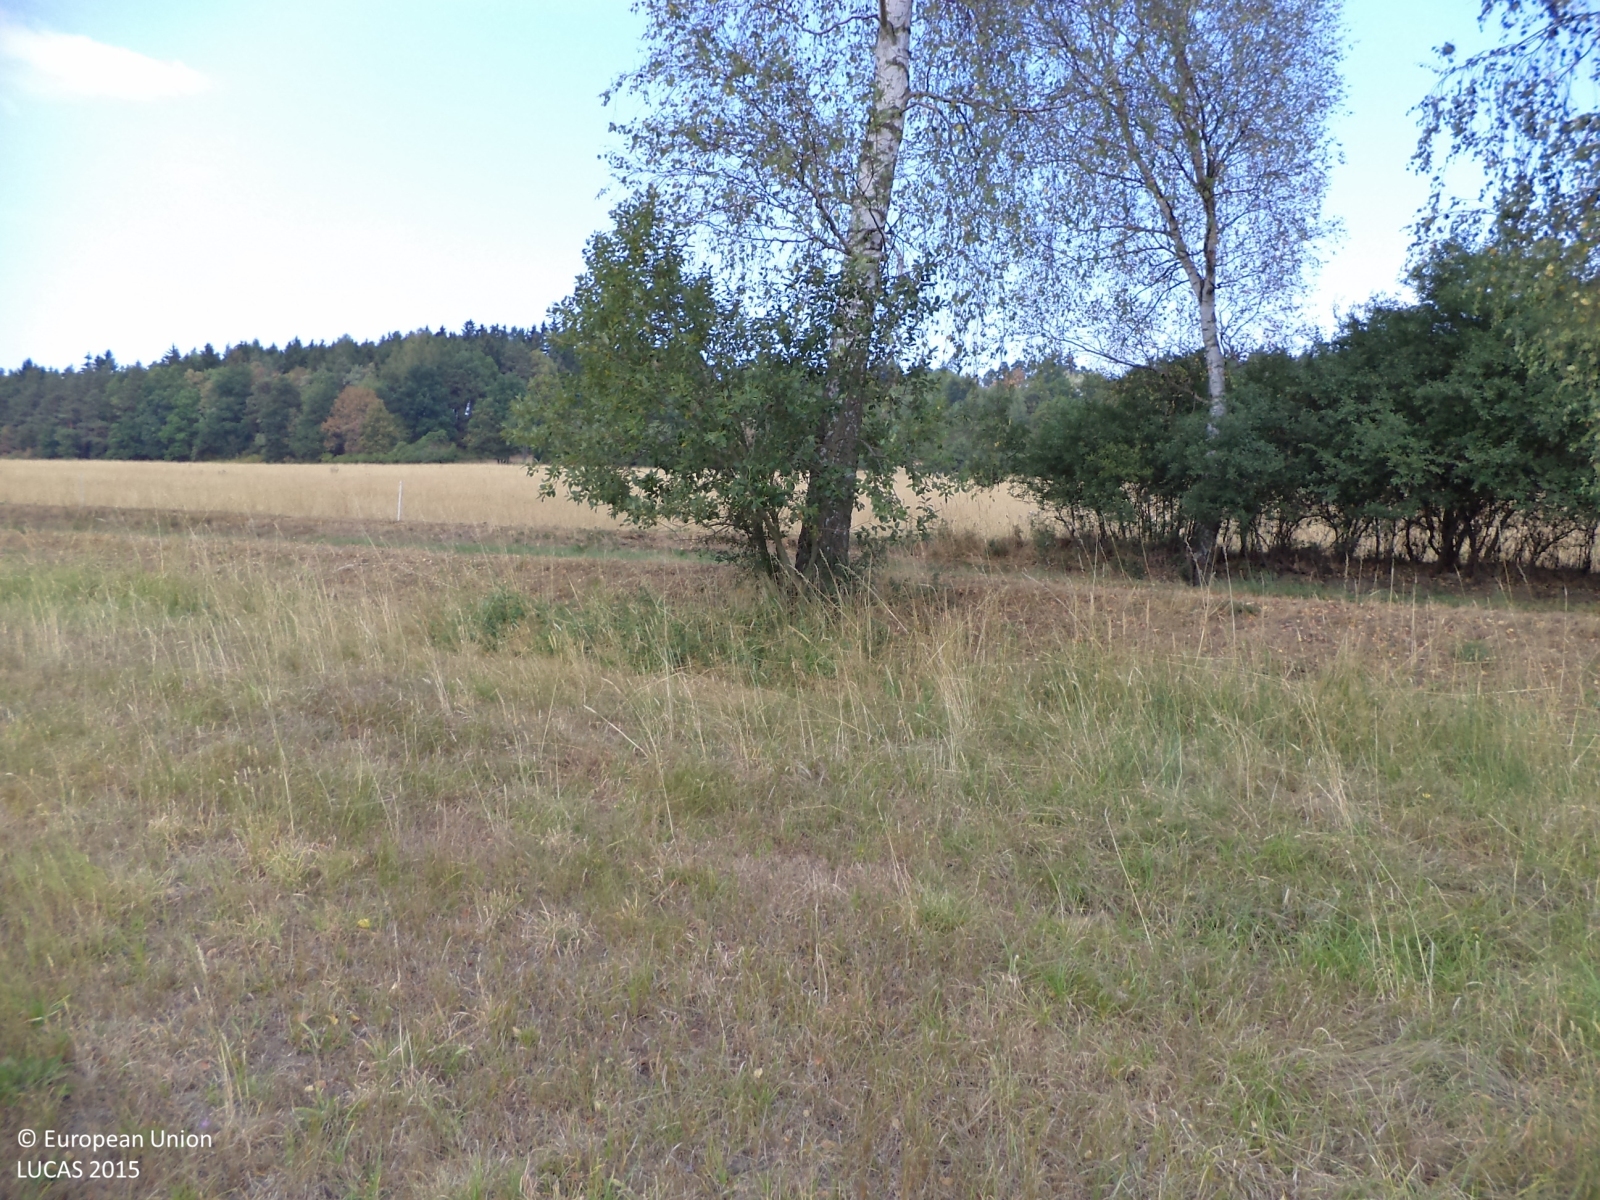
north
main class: Grassland
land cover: Grassland without tree/shrub cover
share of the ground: > 75 %
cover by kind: herbaceous plants 100 %
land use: Agriculture (excluding fallow land and kitchen gardens)
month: August
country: CZ
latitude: 49.4667
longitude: 14.4583
